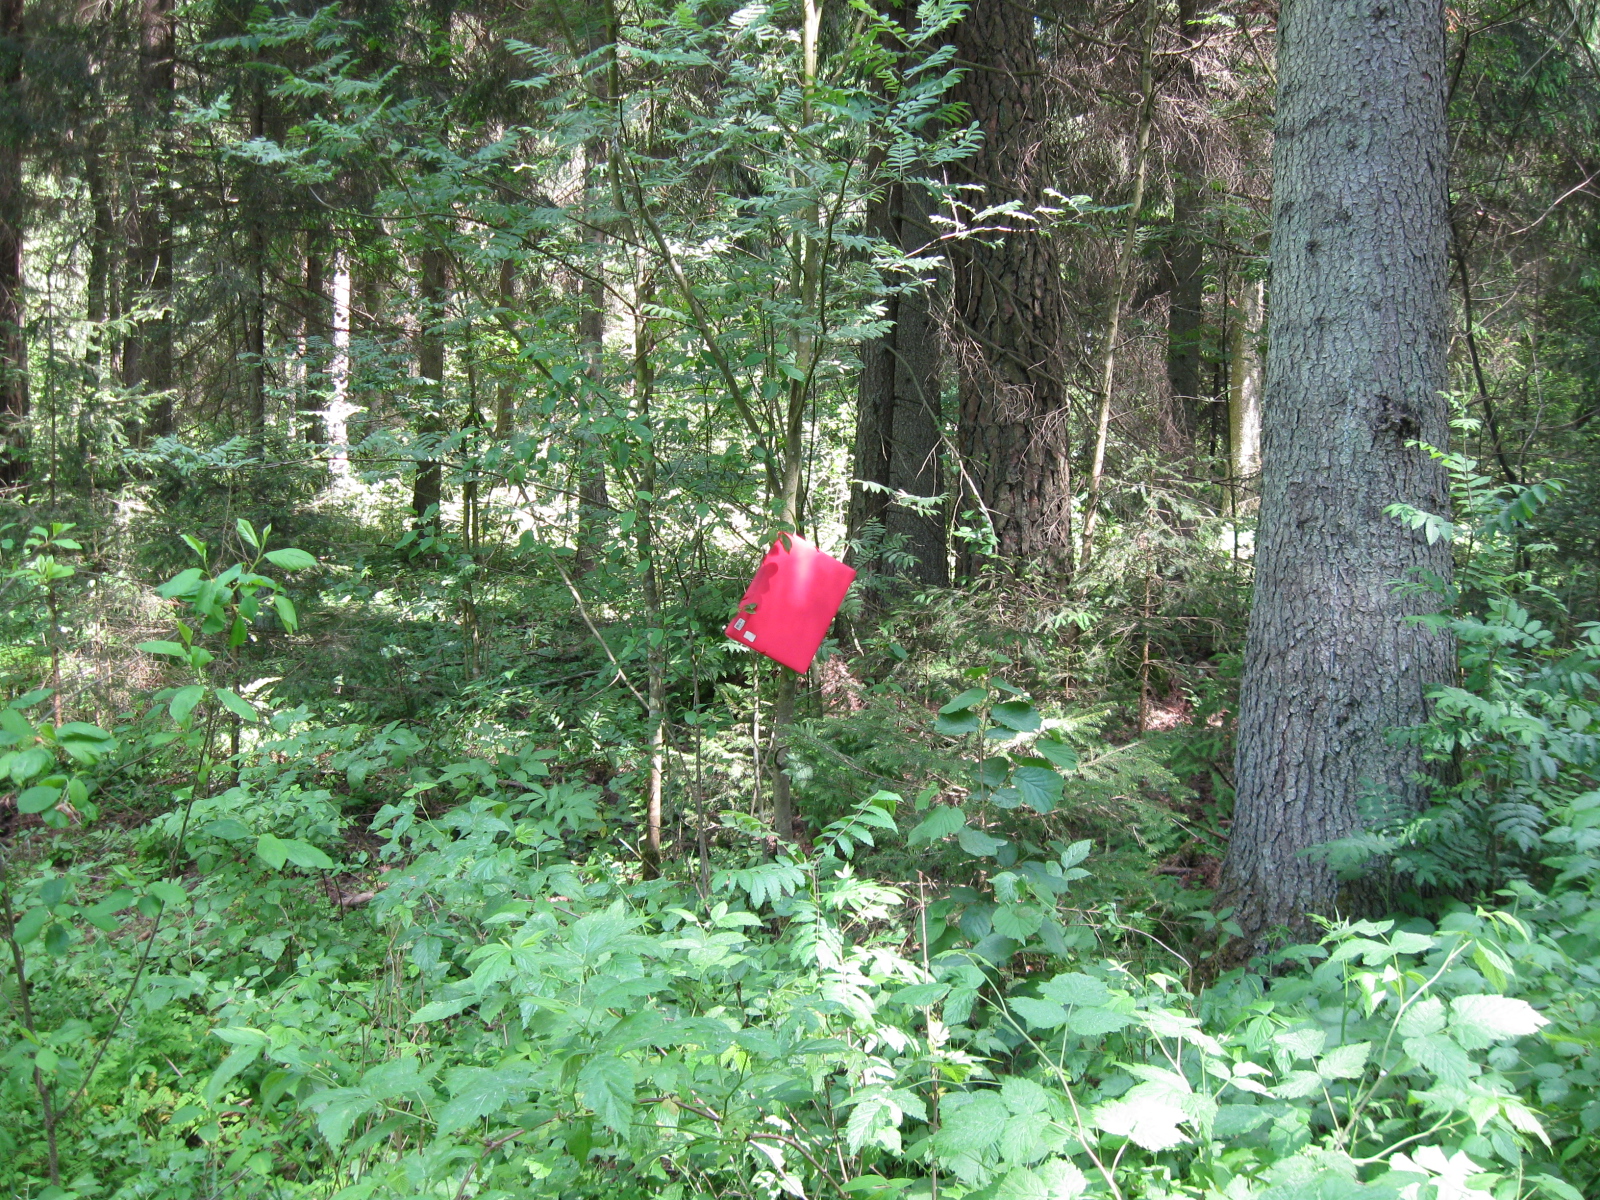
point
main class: Woodland
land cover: Spruce dominated mixed woodland
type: hemiboreal forest and nemoral coniferous forest and mixed broadleaved-coniferous forest
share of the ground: > 75 %
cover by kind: coniferous forest trees 65 %, broadleaved forest trees 30 %, herbaceous plants 5 %
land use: Forestry
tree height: > 5 m
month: June
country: LT
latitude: 54.6268
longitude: 23.8589
